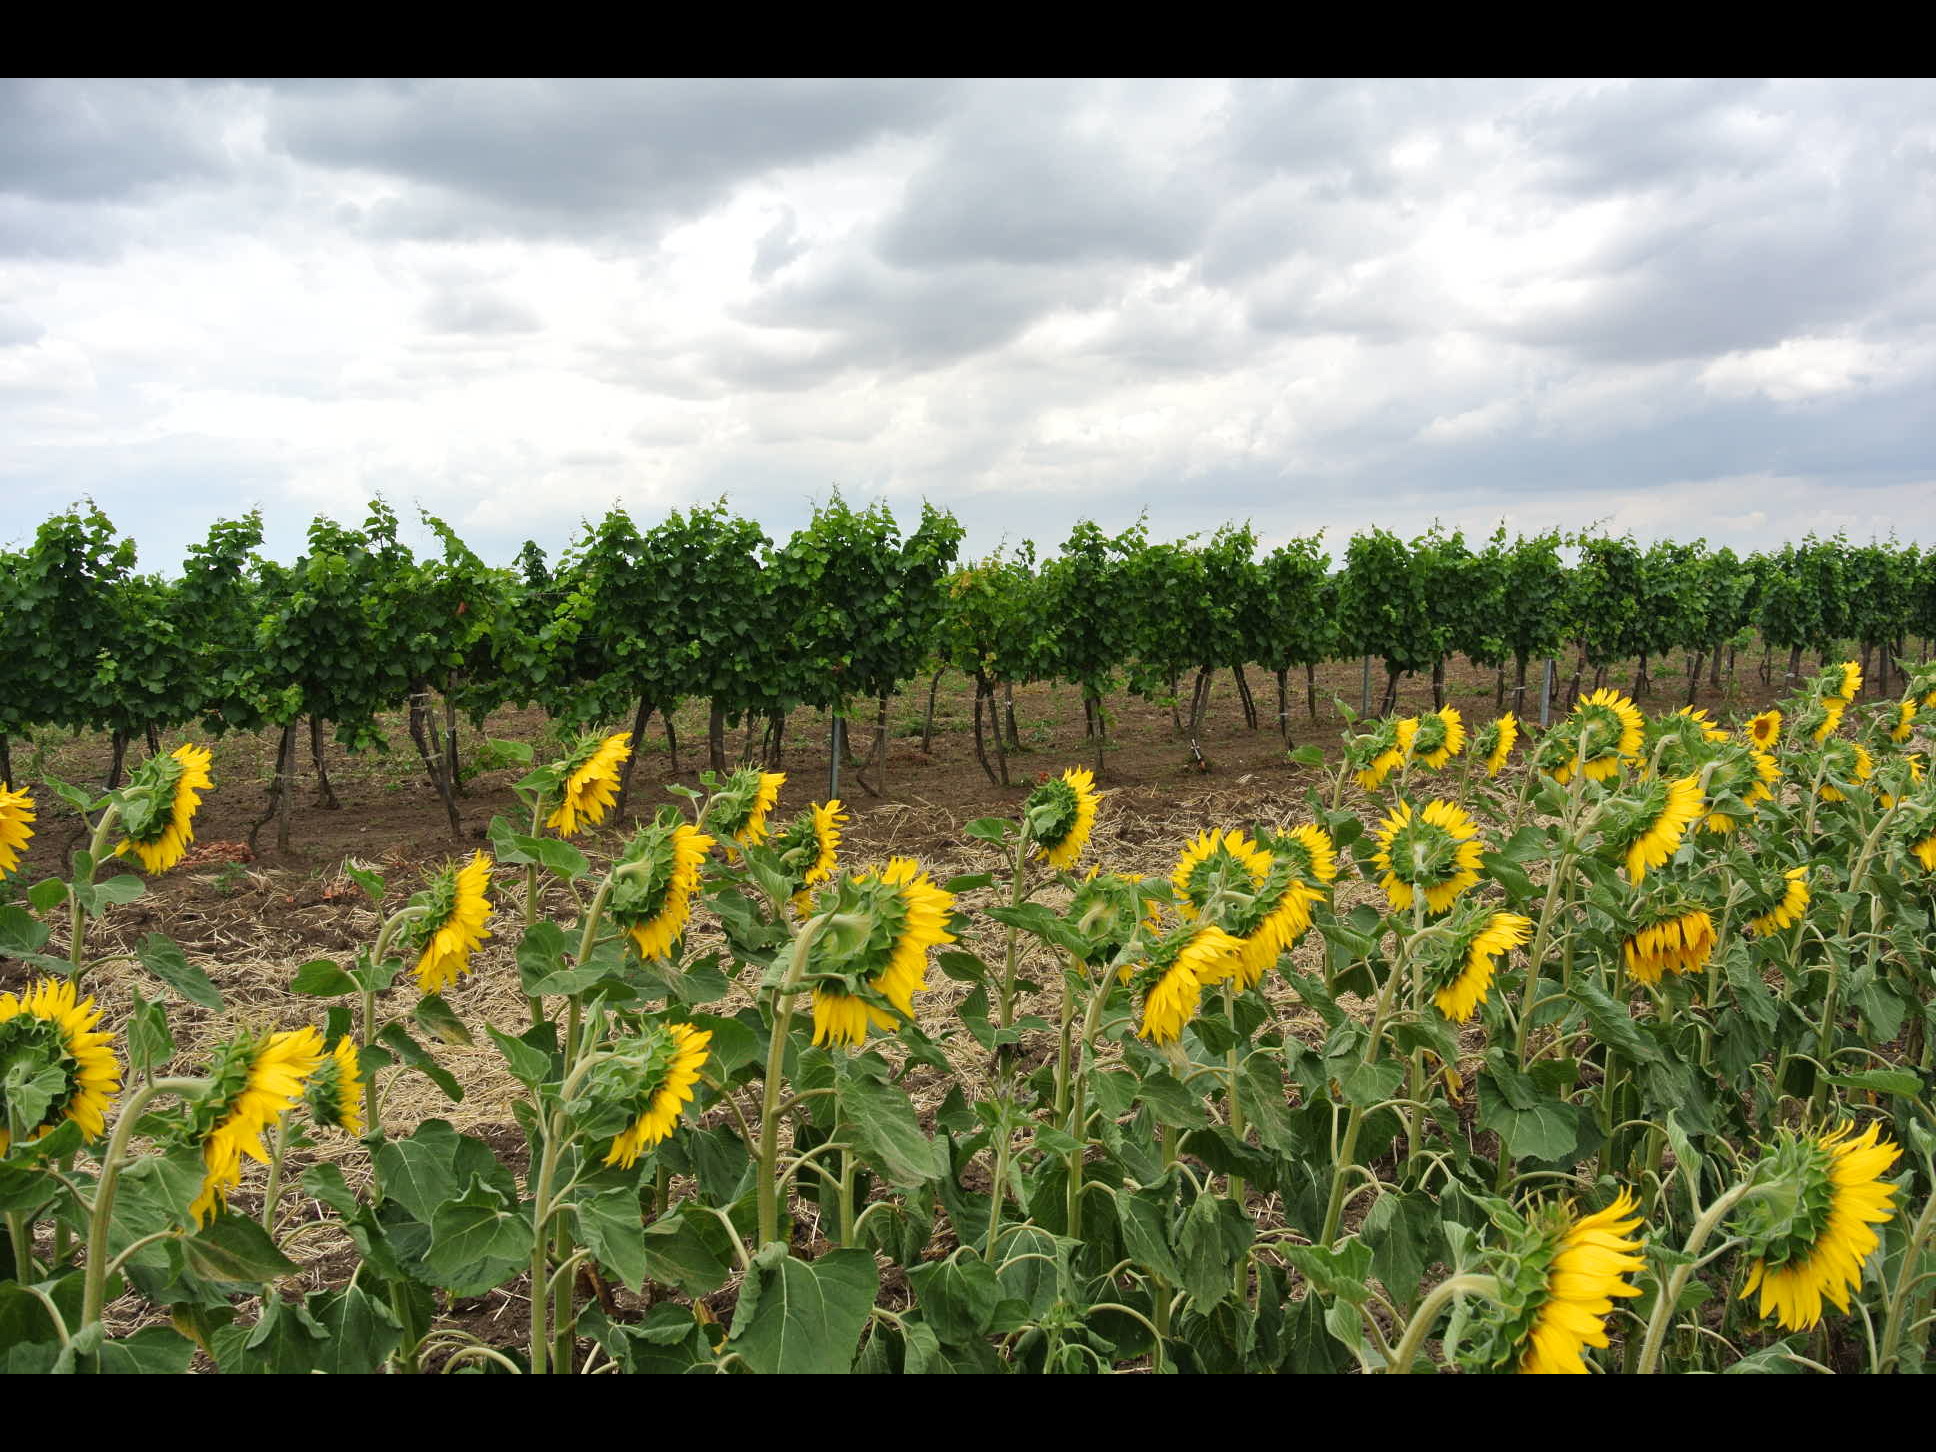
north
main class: Cropland
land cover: Sunflower
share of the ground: > 75 %
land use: Agriculture (excluding fallow land and kitchen gardens)
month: July
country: AT
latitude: 47.8617
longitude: 16.9171
